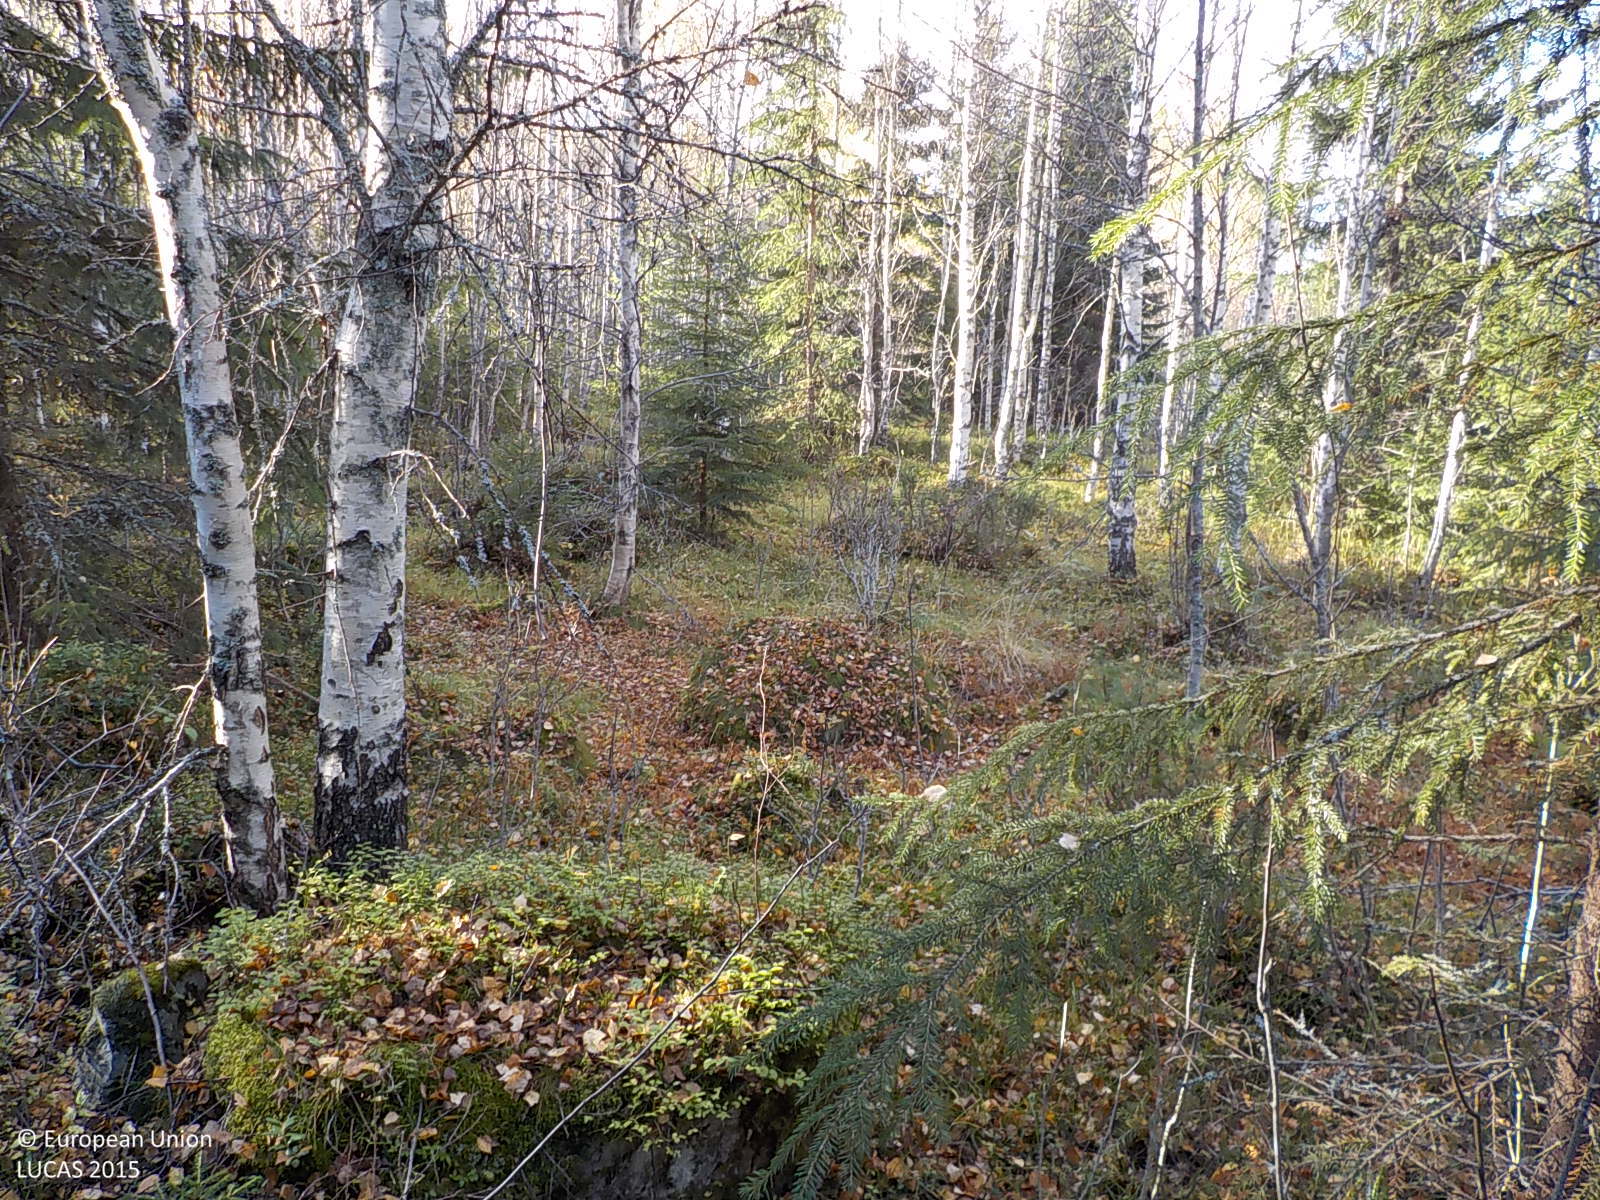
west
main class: Woodland
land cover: Broadleaved woodland
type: hemiboreal forest and nemoral coniferous forest and mixed broadleaved-coniferous forest
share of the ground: 50 - 75 %
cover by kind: broadleaved forest trees 60 %, shrubs 20 %, coniferous forest trees 10 %, lichens and mosses 10 %
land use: Forestry
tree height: > 5 m
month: October
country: SE
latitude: 62.9828
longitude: 18.2862
